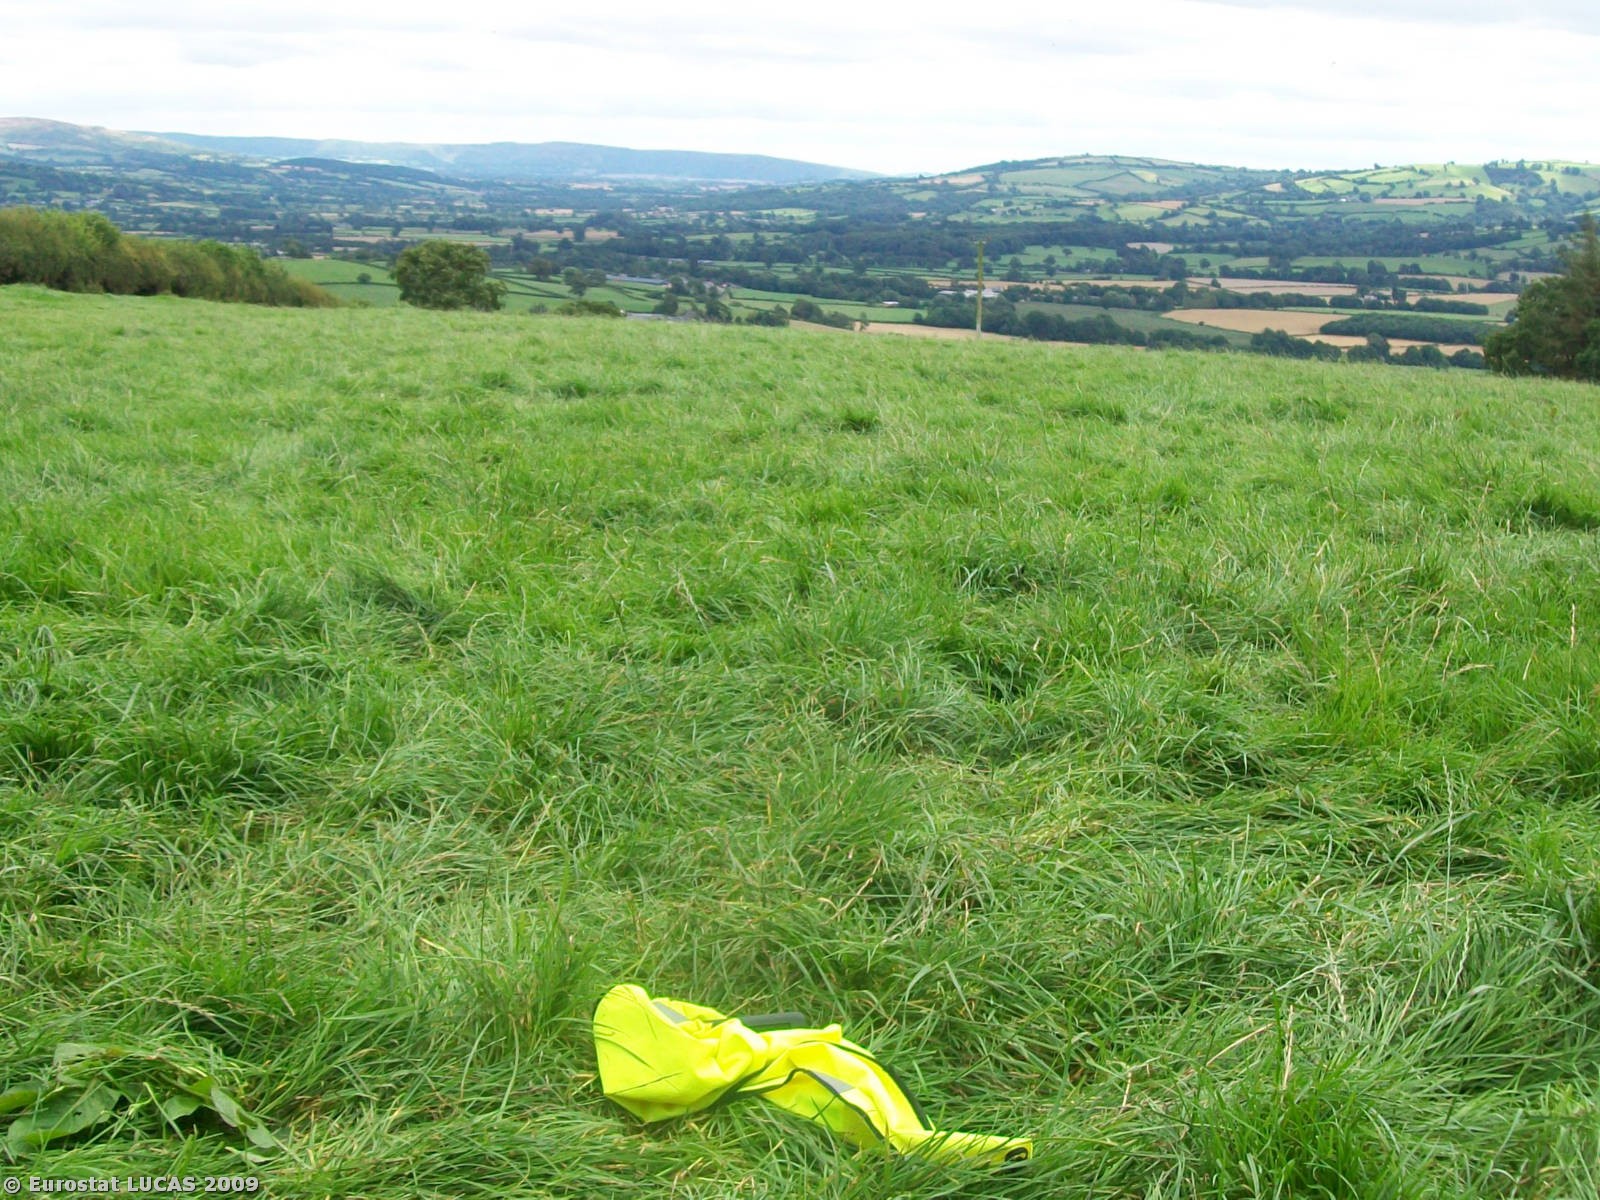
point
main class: Grassland
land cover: Grassland without tree/shrub cover
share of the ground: > 75 %
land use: Agriculture (excluding fallow land and kitchen gardens)
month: August
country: GB
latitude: 52.5344
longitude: -3.1542
